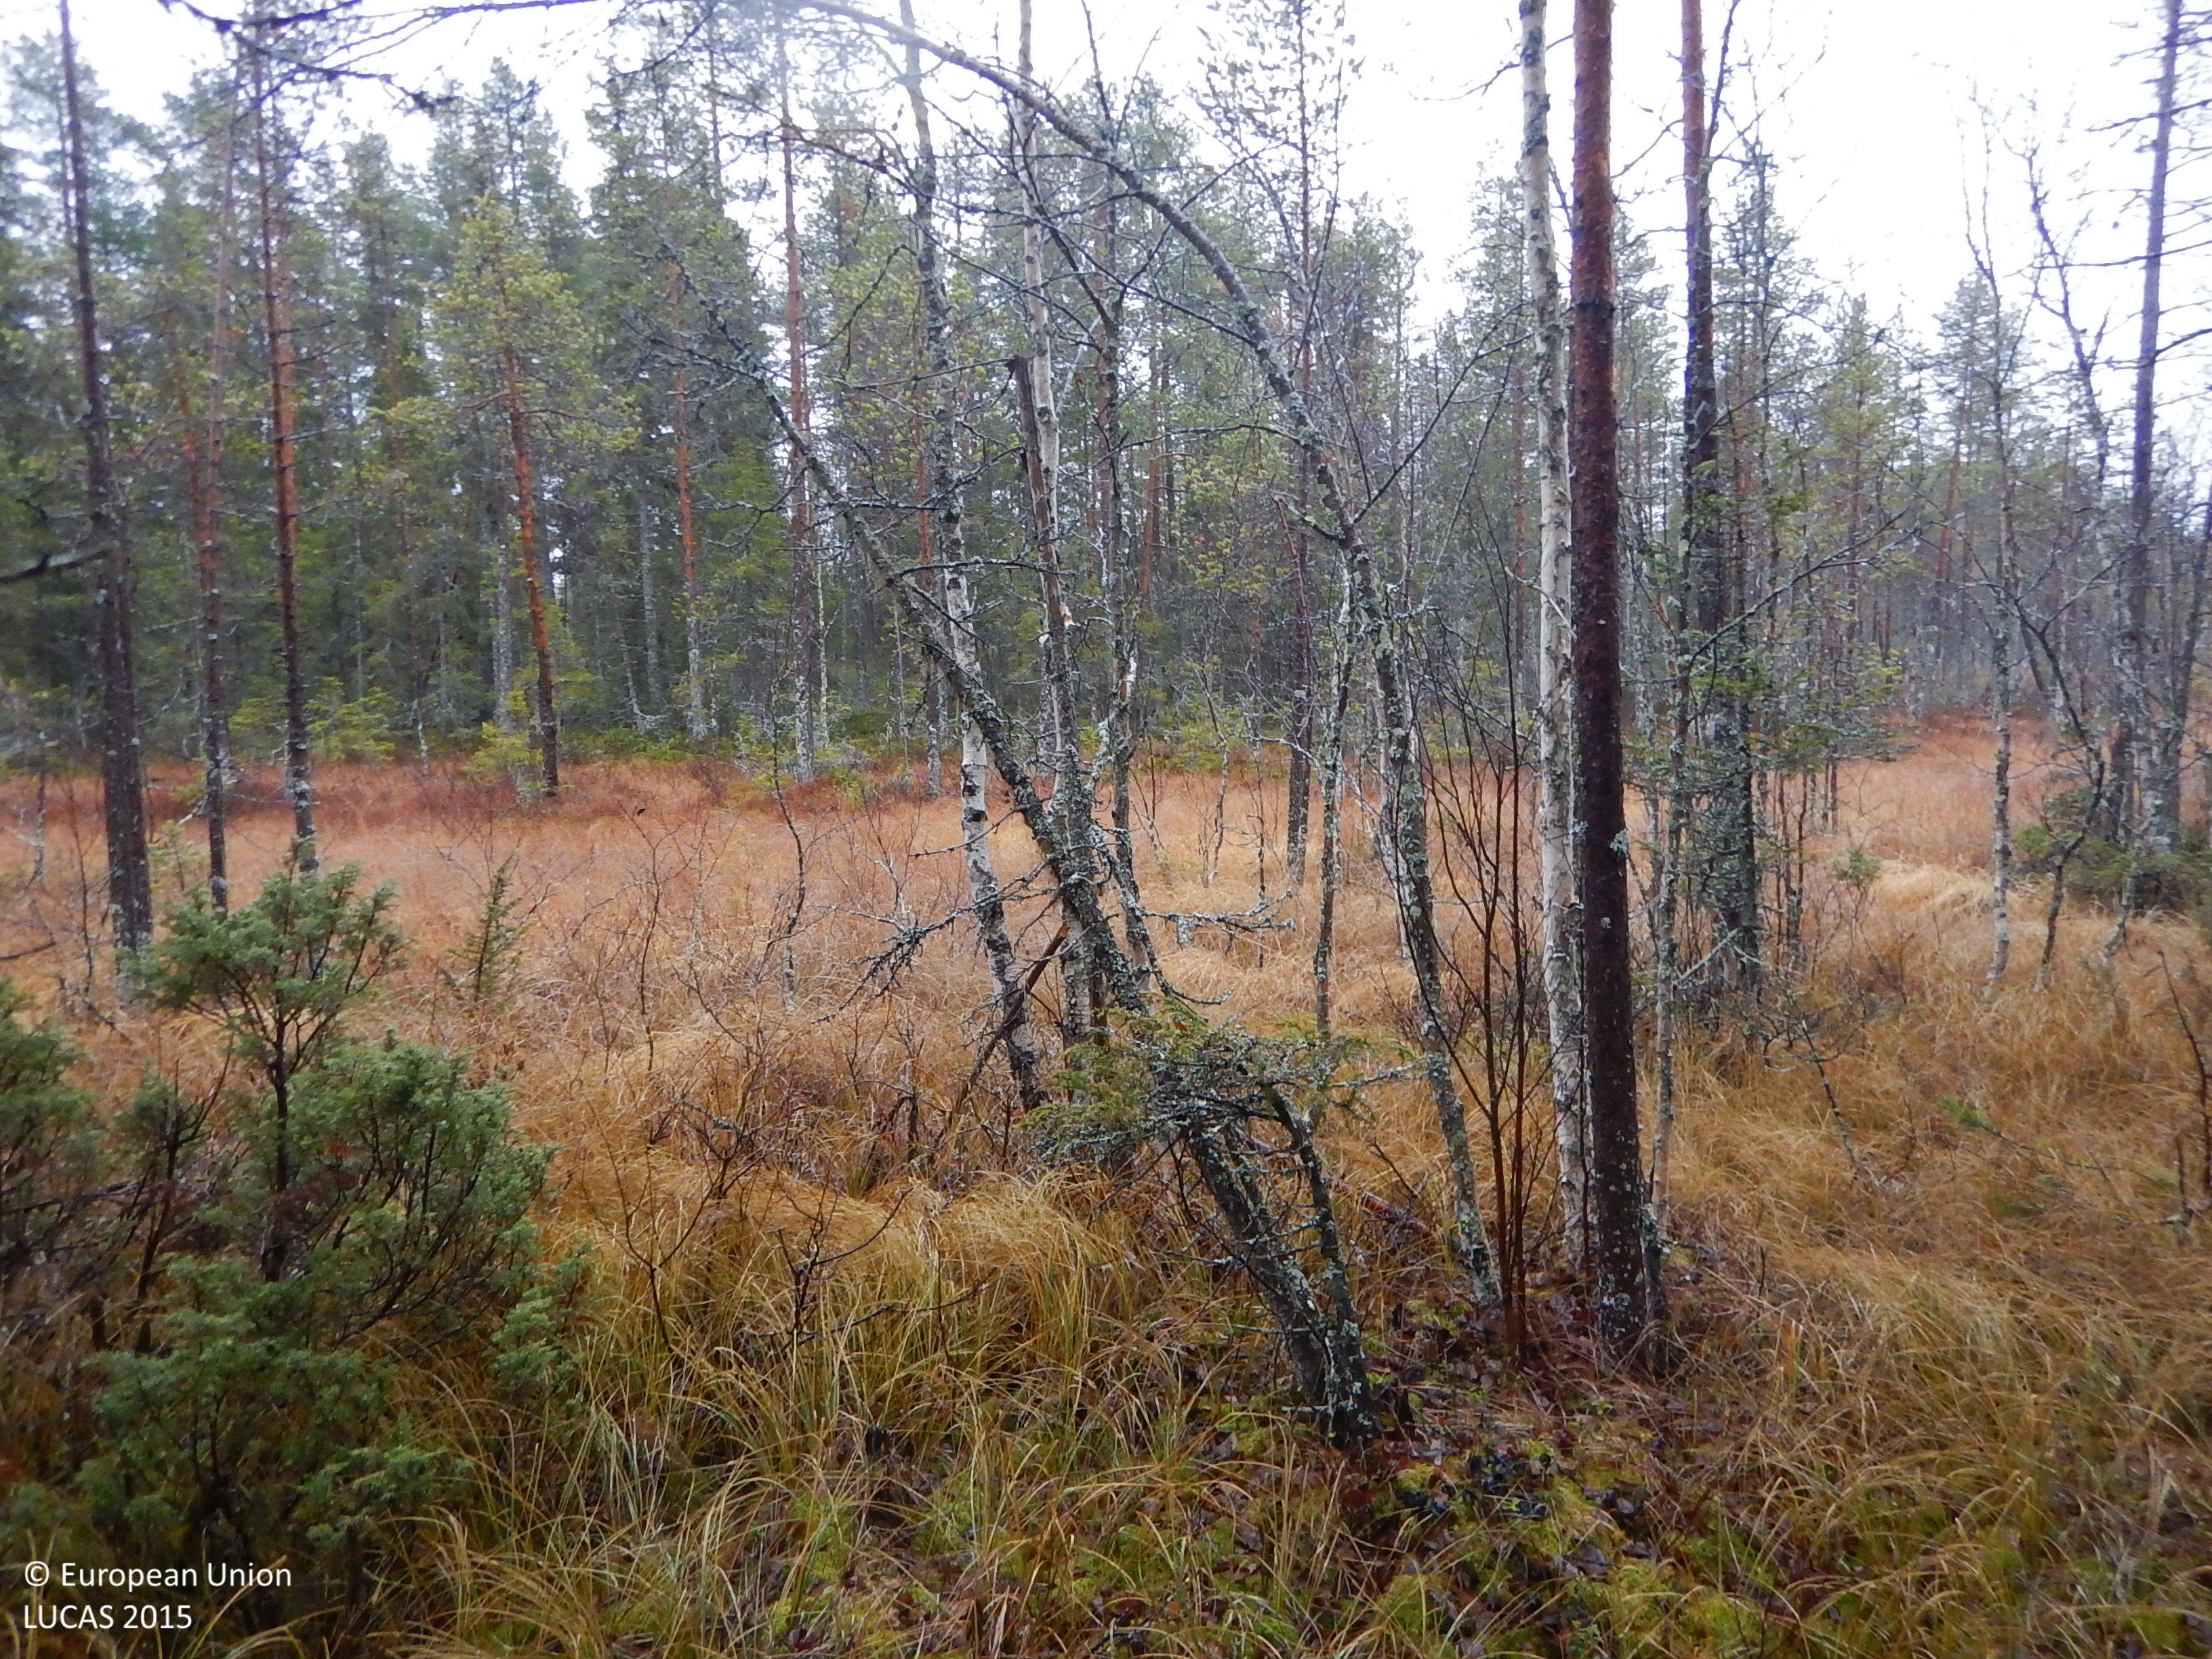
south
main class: Woodland
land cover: Other mixed woodland
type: boreal forest
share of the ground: 50 - 75 %
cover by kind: coniferous forest trees 40 %, lichens and mosses 20 %, broadleaved forest trees 15 %, shrubs 15 %, herbaceous plants 10 %
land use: Forestry
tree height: > 5 m
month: November
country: SE
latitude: 65.1073
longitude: 20.5108
